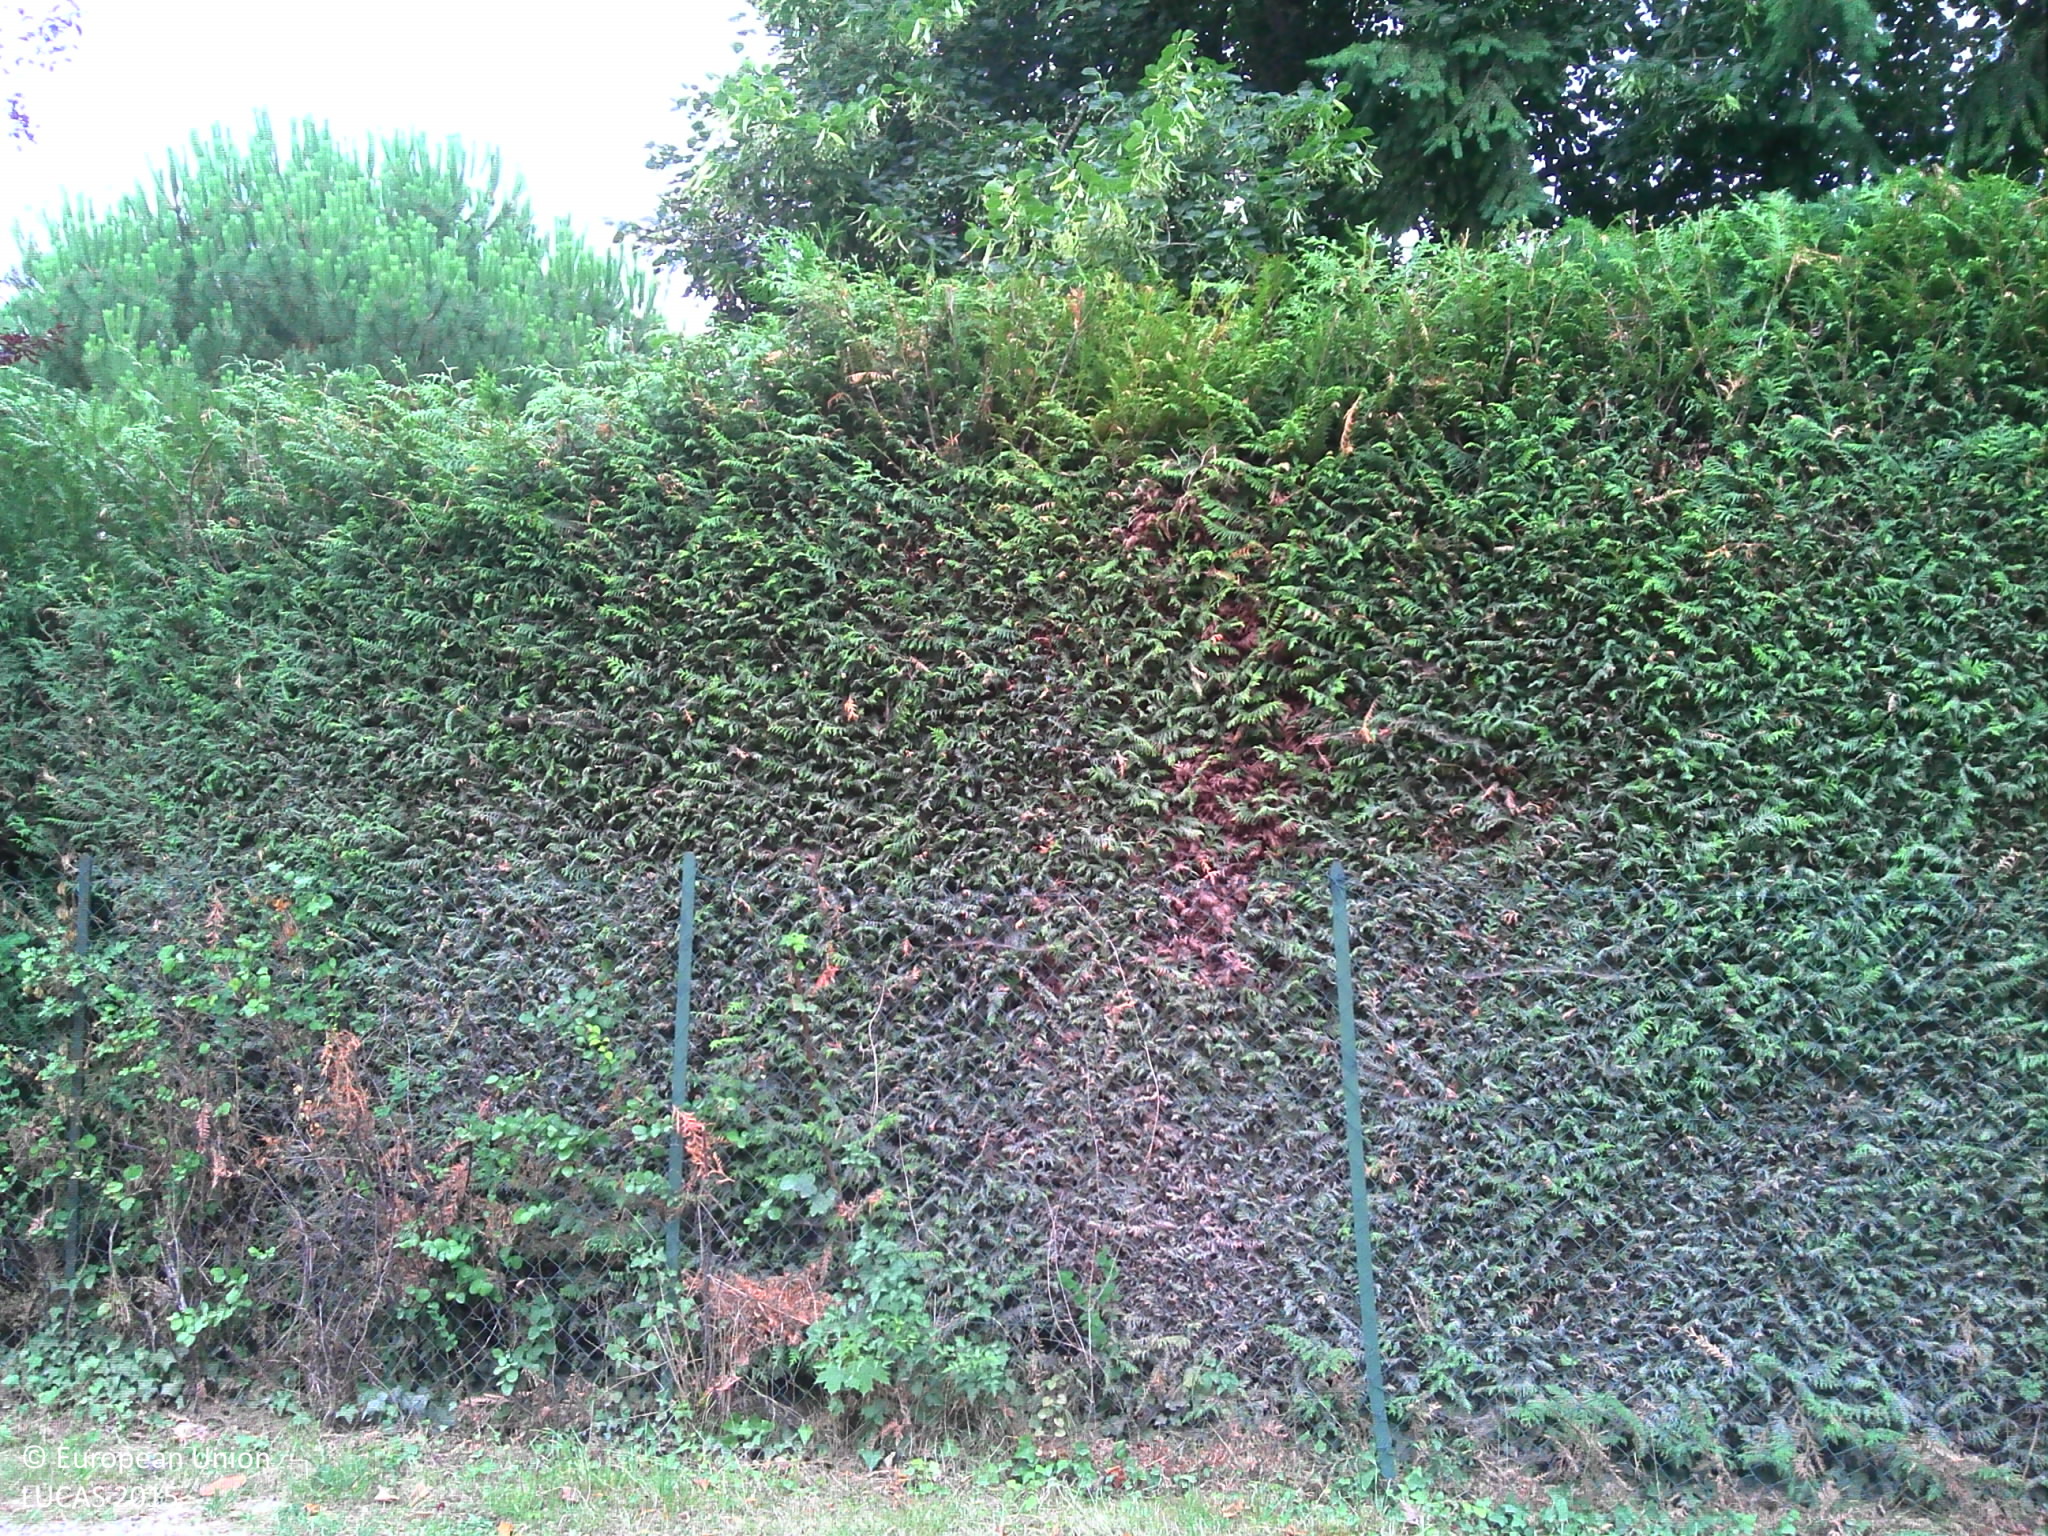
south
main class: Woodland
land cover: Broadleaved woodland
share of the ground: > 75 %
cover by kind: broadleaved forest trees 50 %, herbaceous plants 25 %, lichens and mosses 10 %, unconsolidated bare surface 10 %, coniferous forest trees 5 %
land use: Residential
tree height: > 5 m
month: July
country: FR
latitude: 48.4548
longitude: 2.7567
